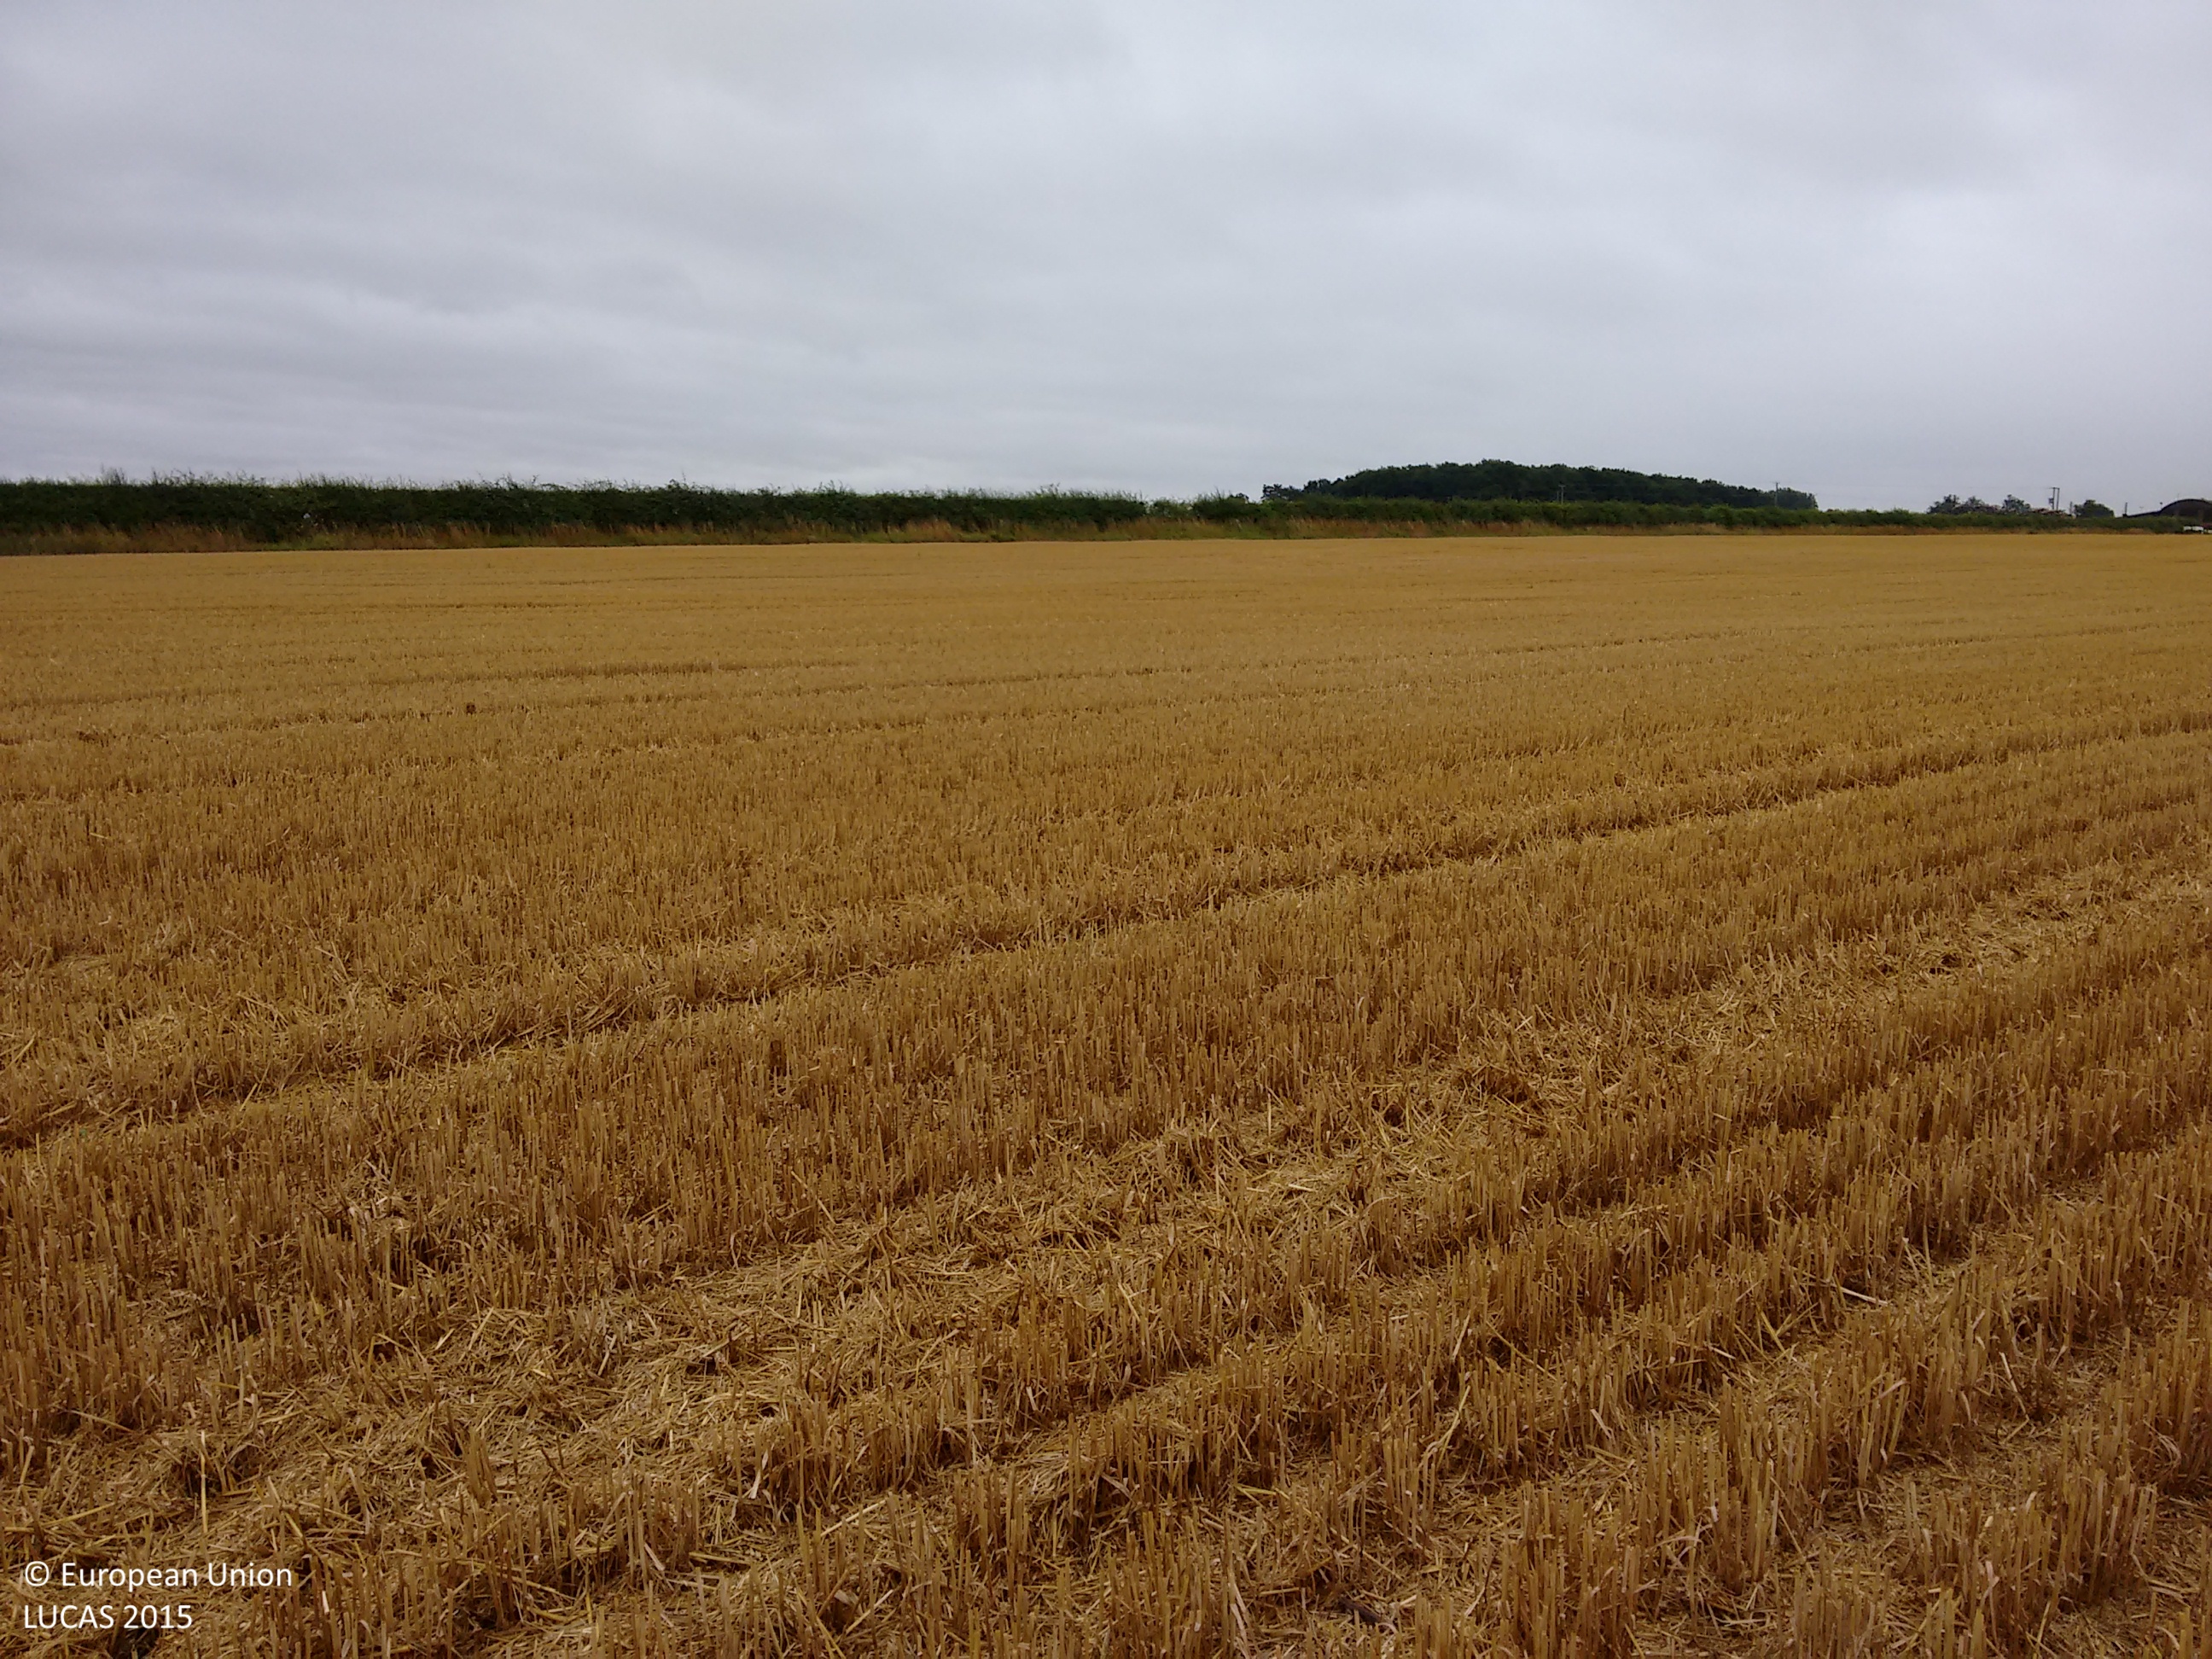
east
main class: Cropland
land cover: Common wheat
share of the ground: > 75 %
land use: Agriculture (excluding fallow land and kitchen gardens)
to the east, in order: Common wheat; Grass margins; Managed hedges; Grass margins; Common wheat
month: August
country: GB
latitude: 52.6068
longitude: -1.4051
